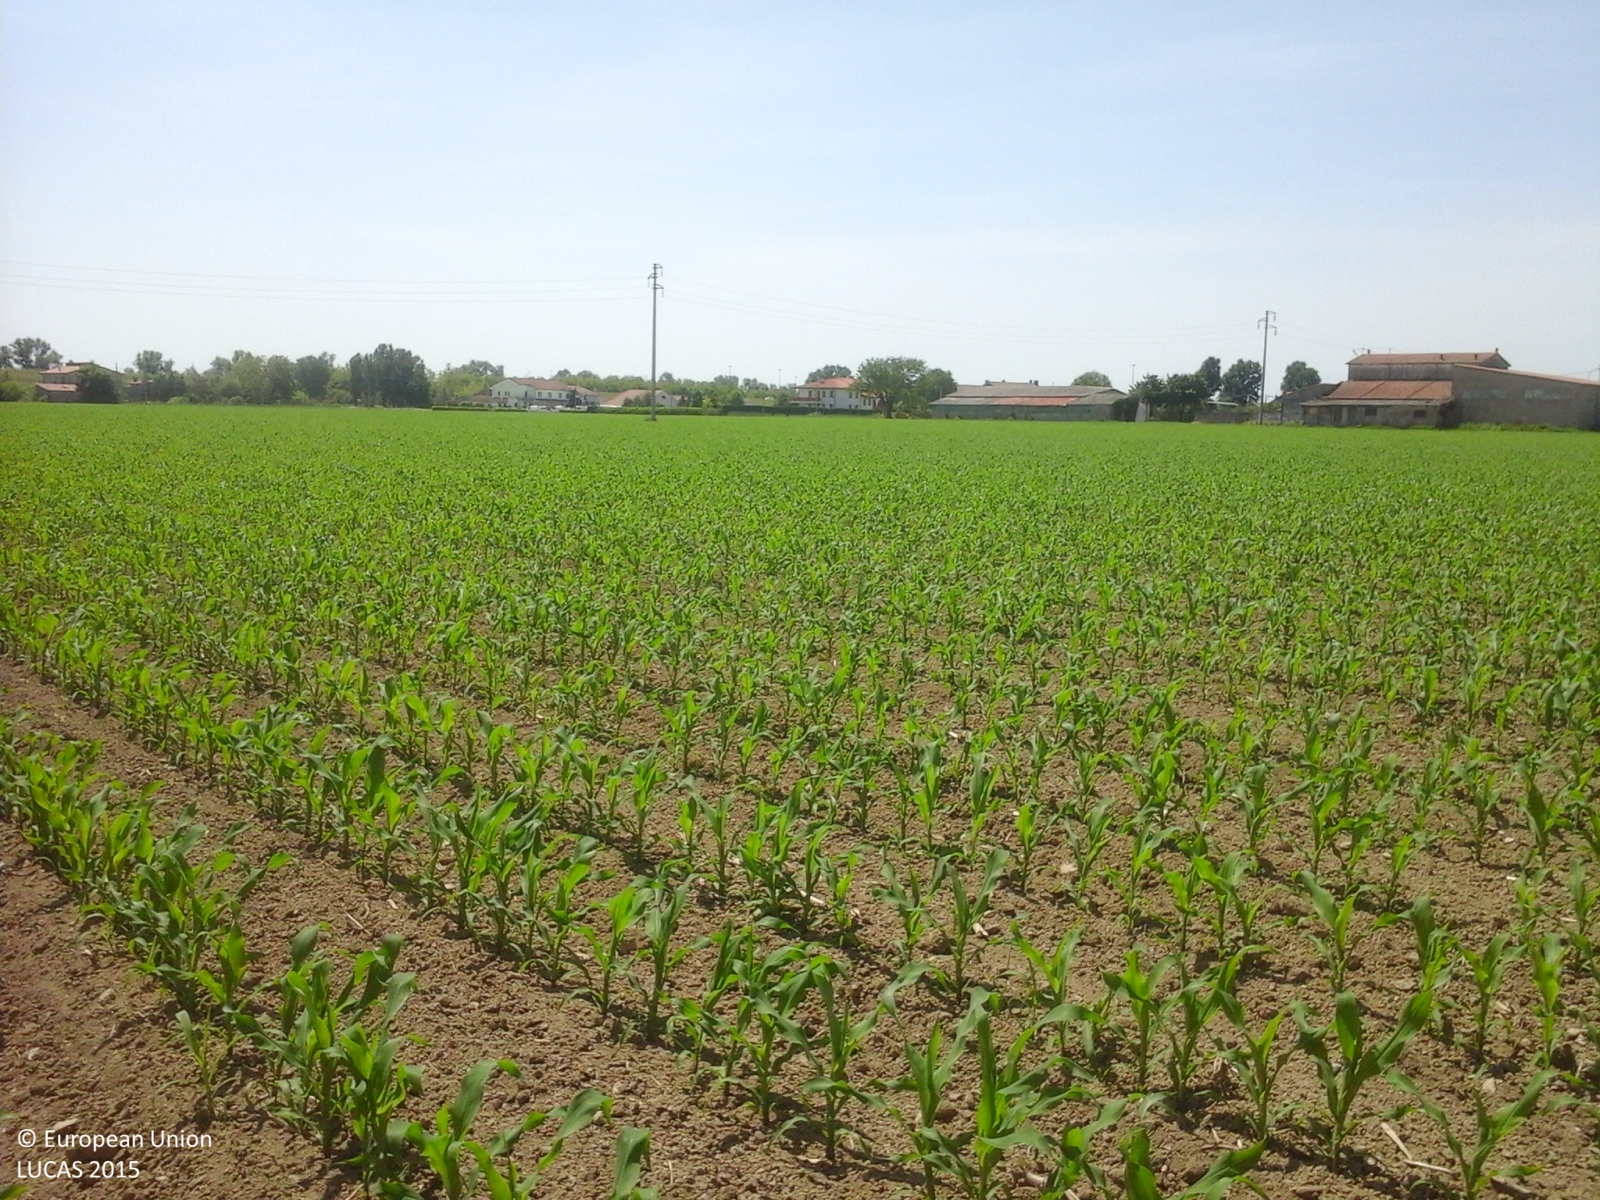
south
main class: Cropland
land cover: Maize
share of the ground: 10 - 25 %
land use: Agriculture (excluding fallow land and kitchen gardens)
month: May
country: IT
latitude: 44.9317
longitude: 11.7073
